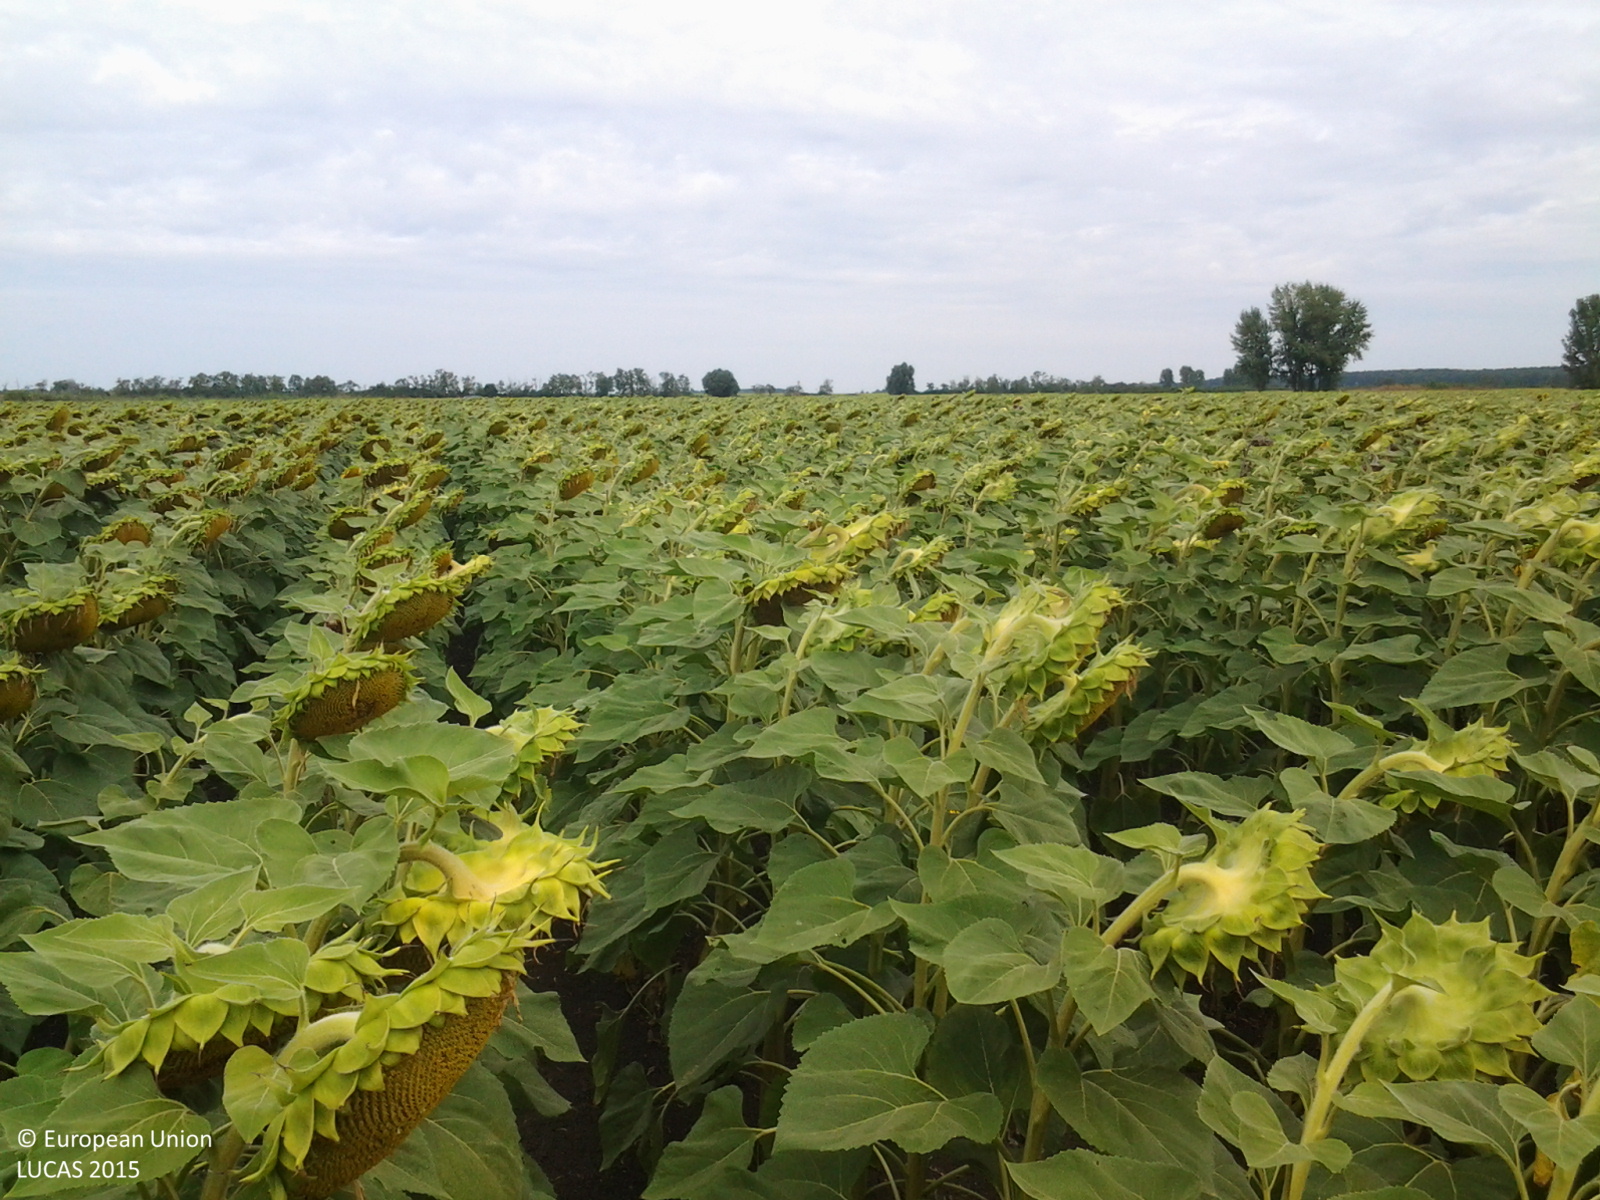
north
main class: Cropland
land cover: Sunflower
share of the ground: > 75 %
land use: Agriculture (excluding fallow land and kitchen gardens)
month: July
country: HU
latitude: 47.0801
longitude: 21.2726
